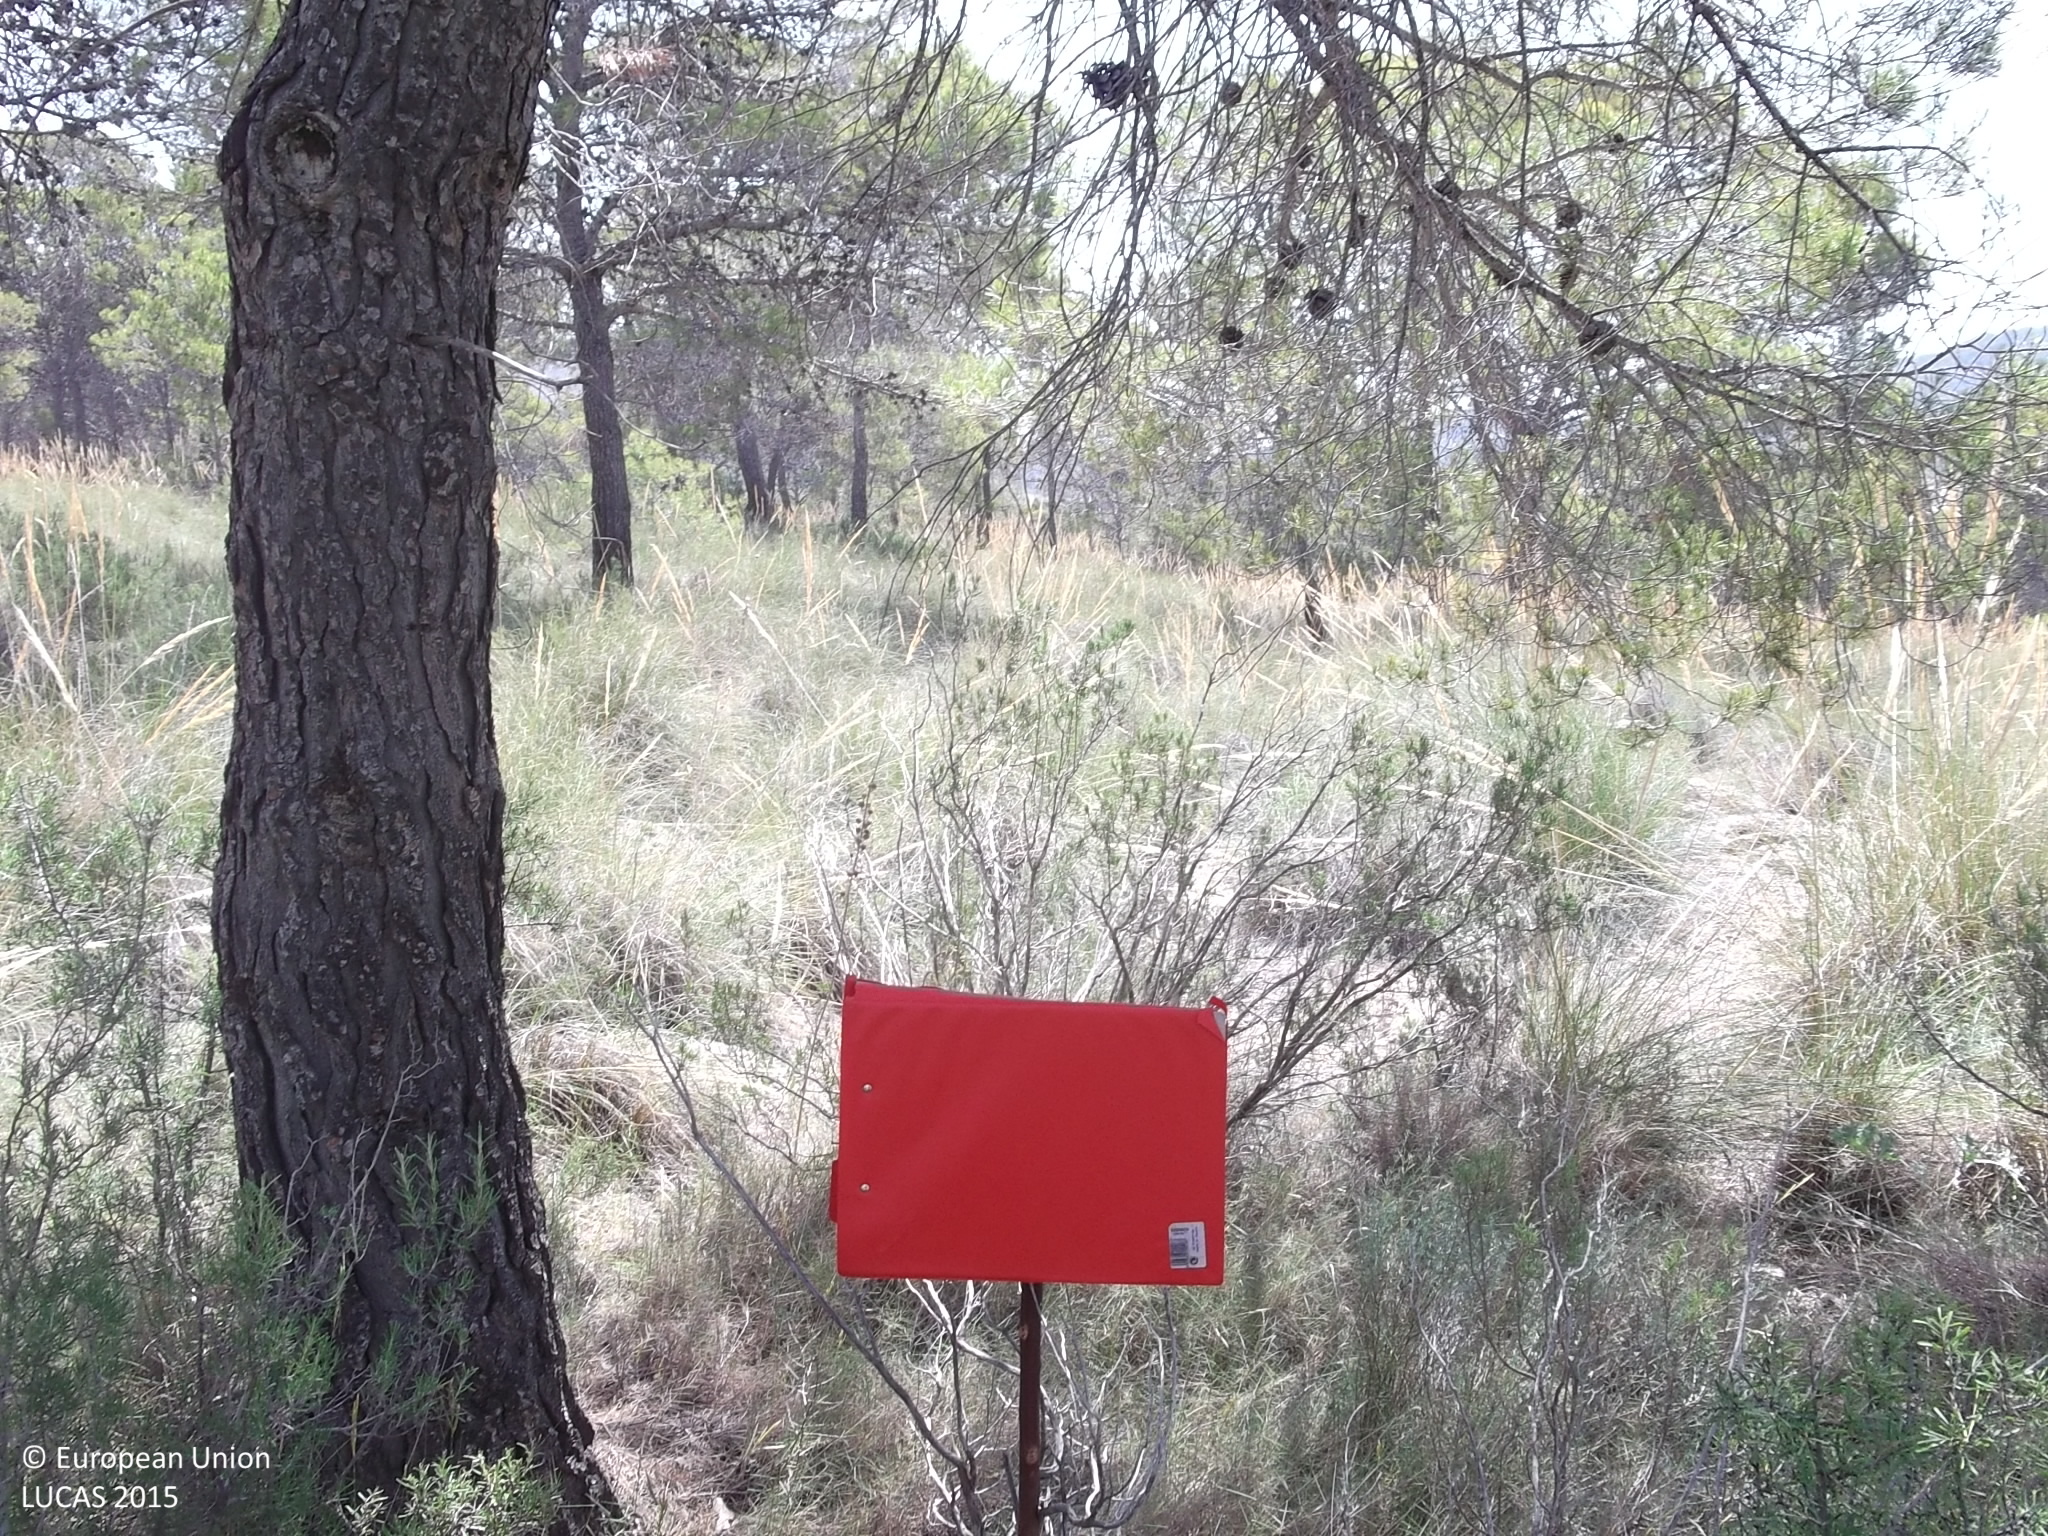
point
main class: Woodland
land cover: Pine dominated coniferous woodland
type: coniferous forest of the mediterranean region
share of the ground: 25 - 50 %
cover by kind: shrubs 35 %, coniferous forest trees 25 %, herbaceous plants 20 %, consolidated bare surface 20 %
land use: Semi-natural and natural areas not in use
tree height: > 5 m
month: June
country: ES
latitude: 38.4023
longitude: -1.3378
